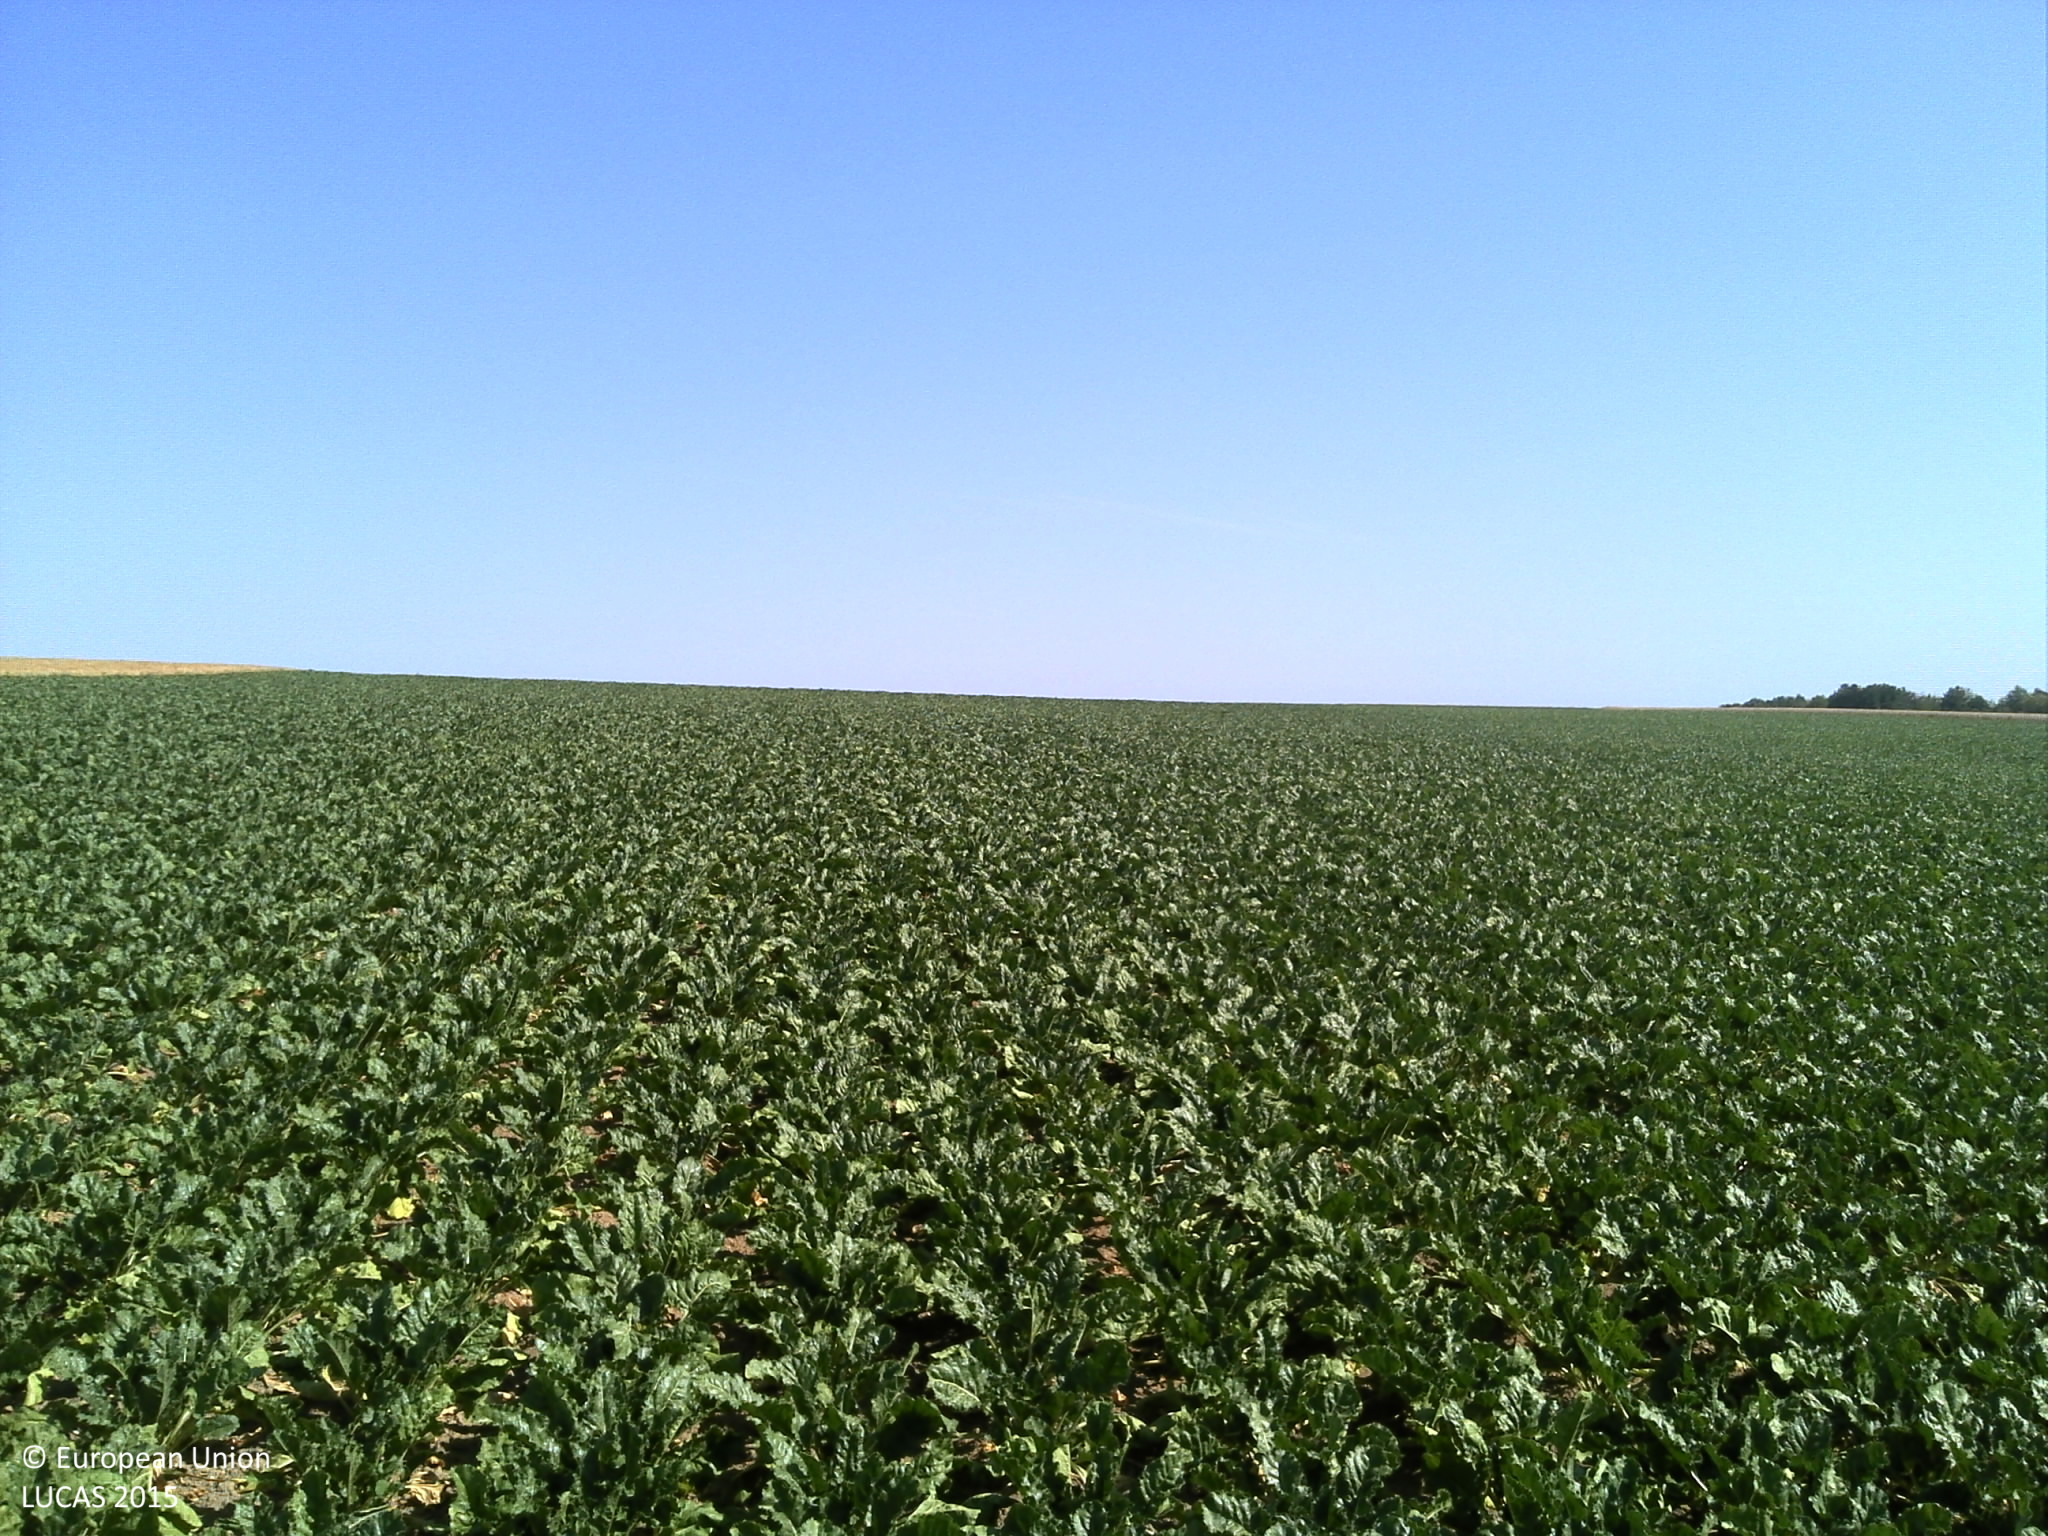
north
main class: Cropland
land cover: Sugar beet
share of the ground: > 75 %
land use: Agriculture (excluding fallow land and kitchen gardens)
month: July
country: FR
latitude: 49.4368
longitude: 4.1067
